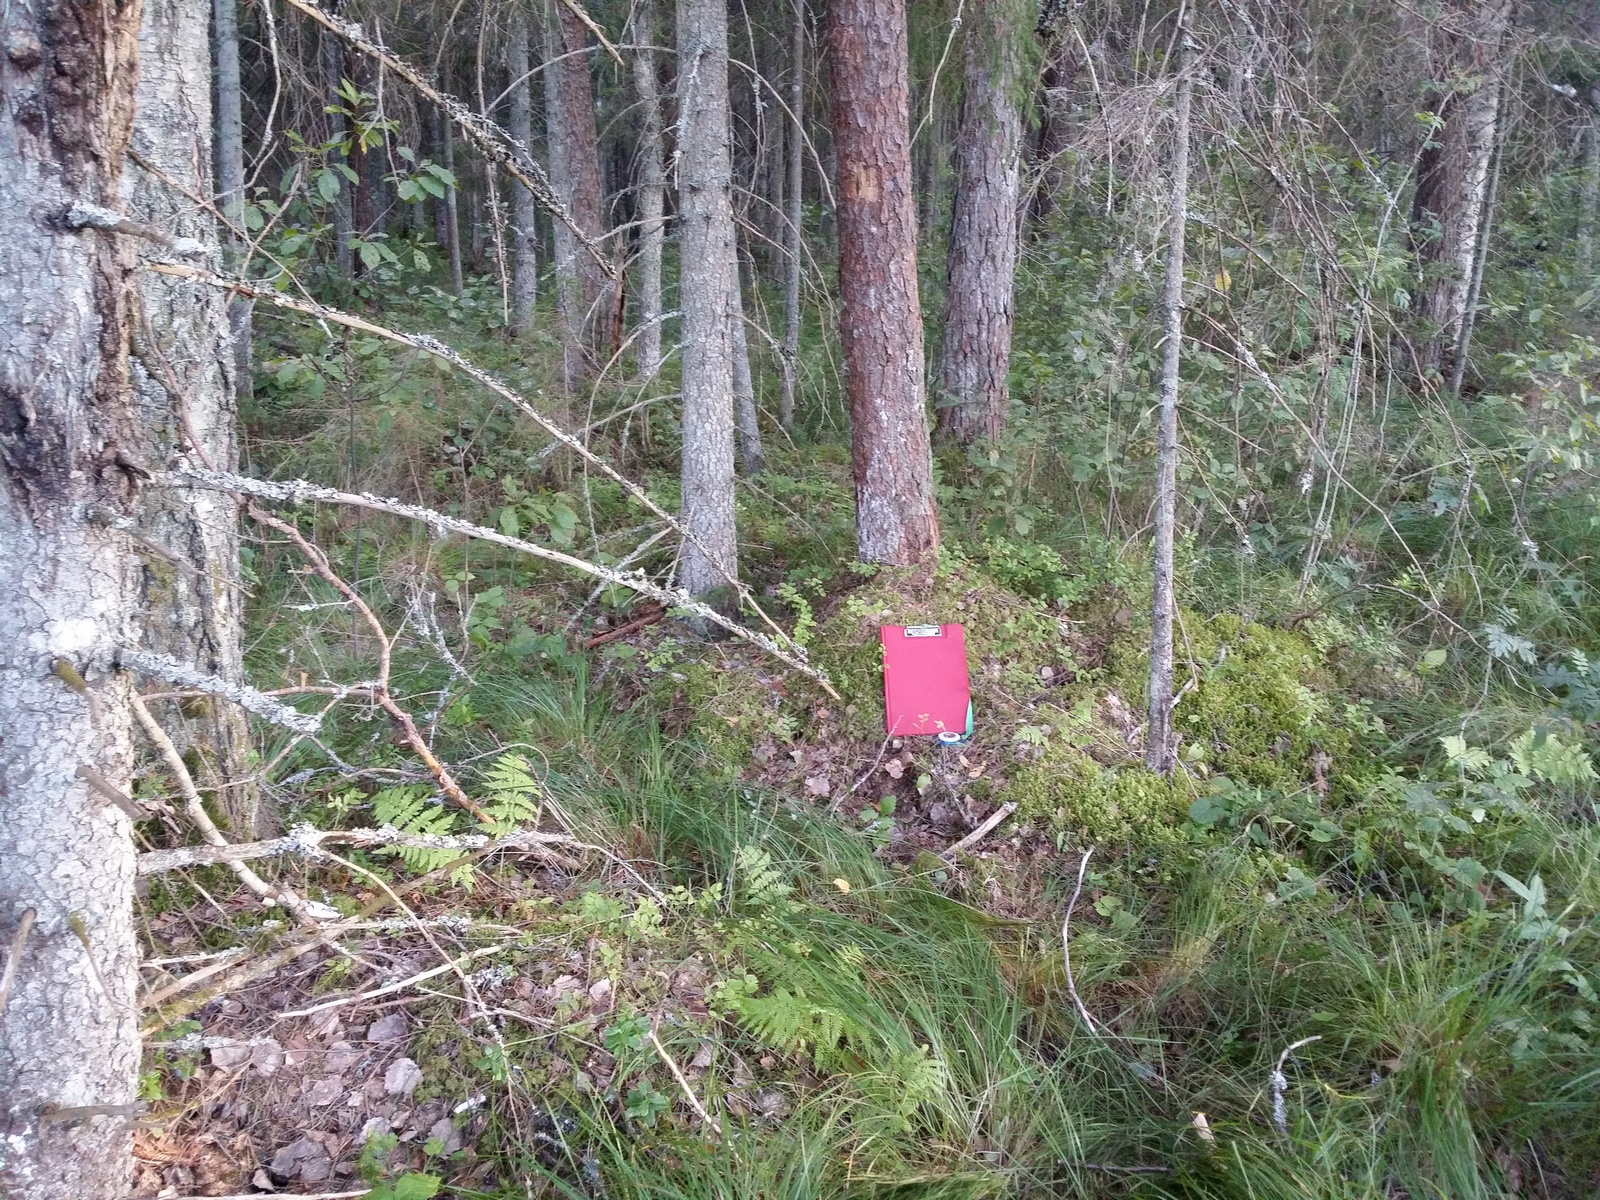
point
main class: Woodland
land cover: Other mixed woodland
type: hemiboreal forest and nemoral coniferous forest and mixed broadleaved-coniferous forest
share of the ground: > 75 %
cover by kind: coniferous forest trees 55 %, broadleaved forest trees 25 %, herbaceous plants 10 %, lichens and mosses 10 %
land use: Forestry
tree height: > 5 m
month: August
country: LV
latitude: 57.5017
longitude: 26.7891
